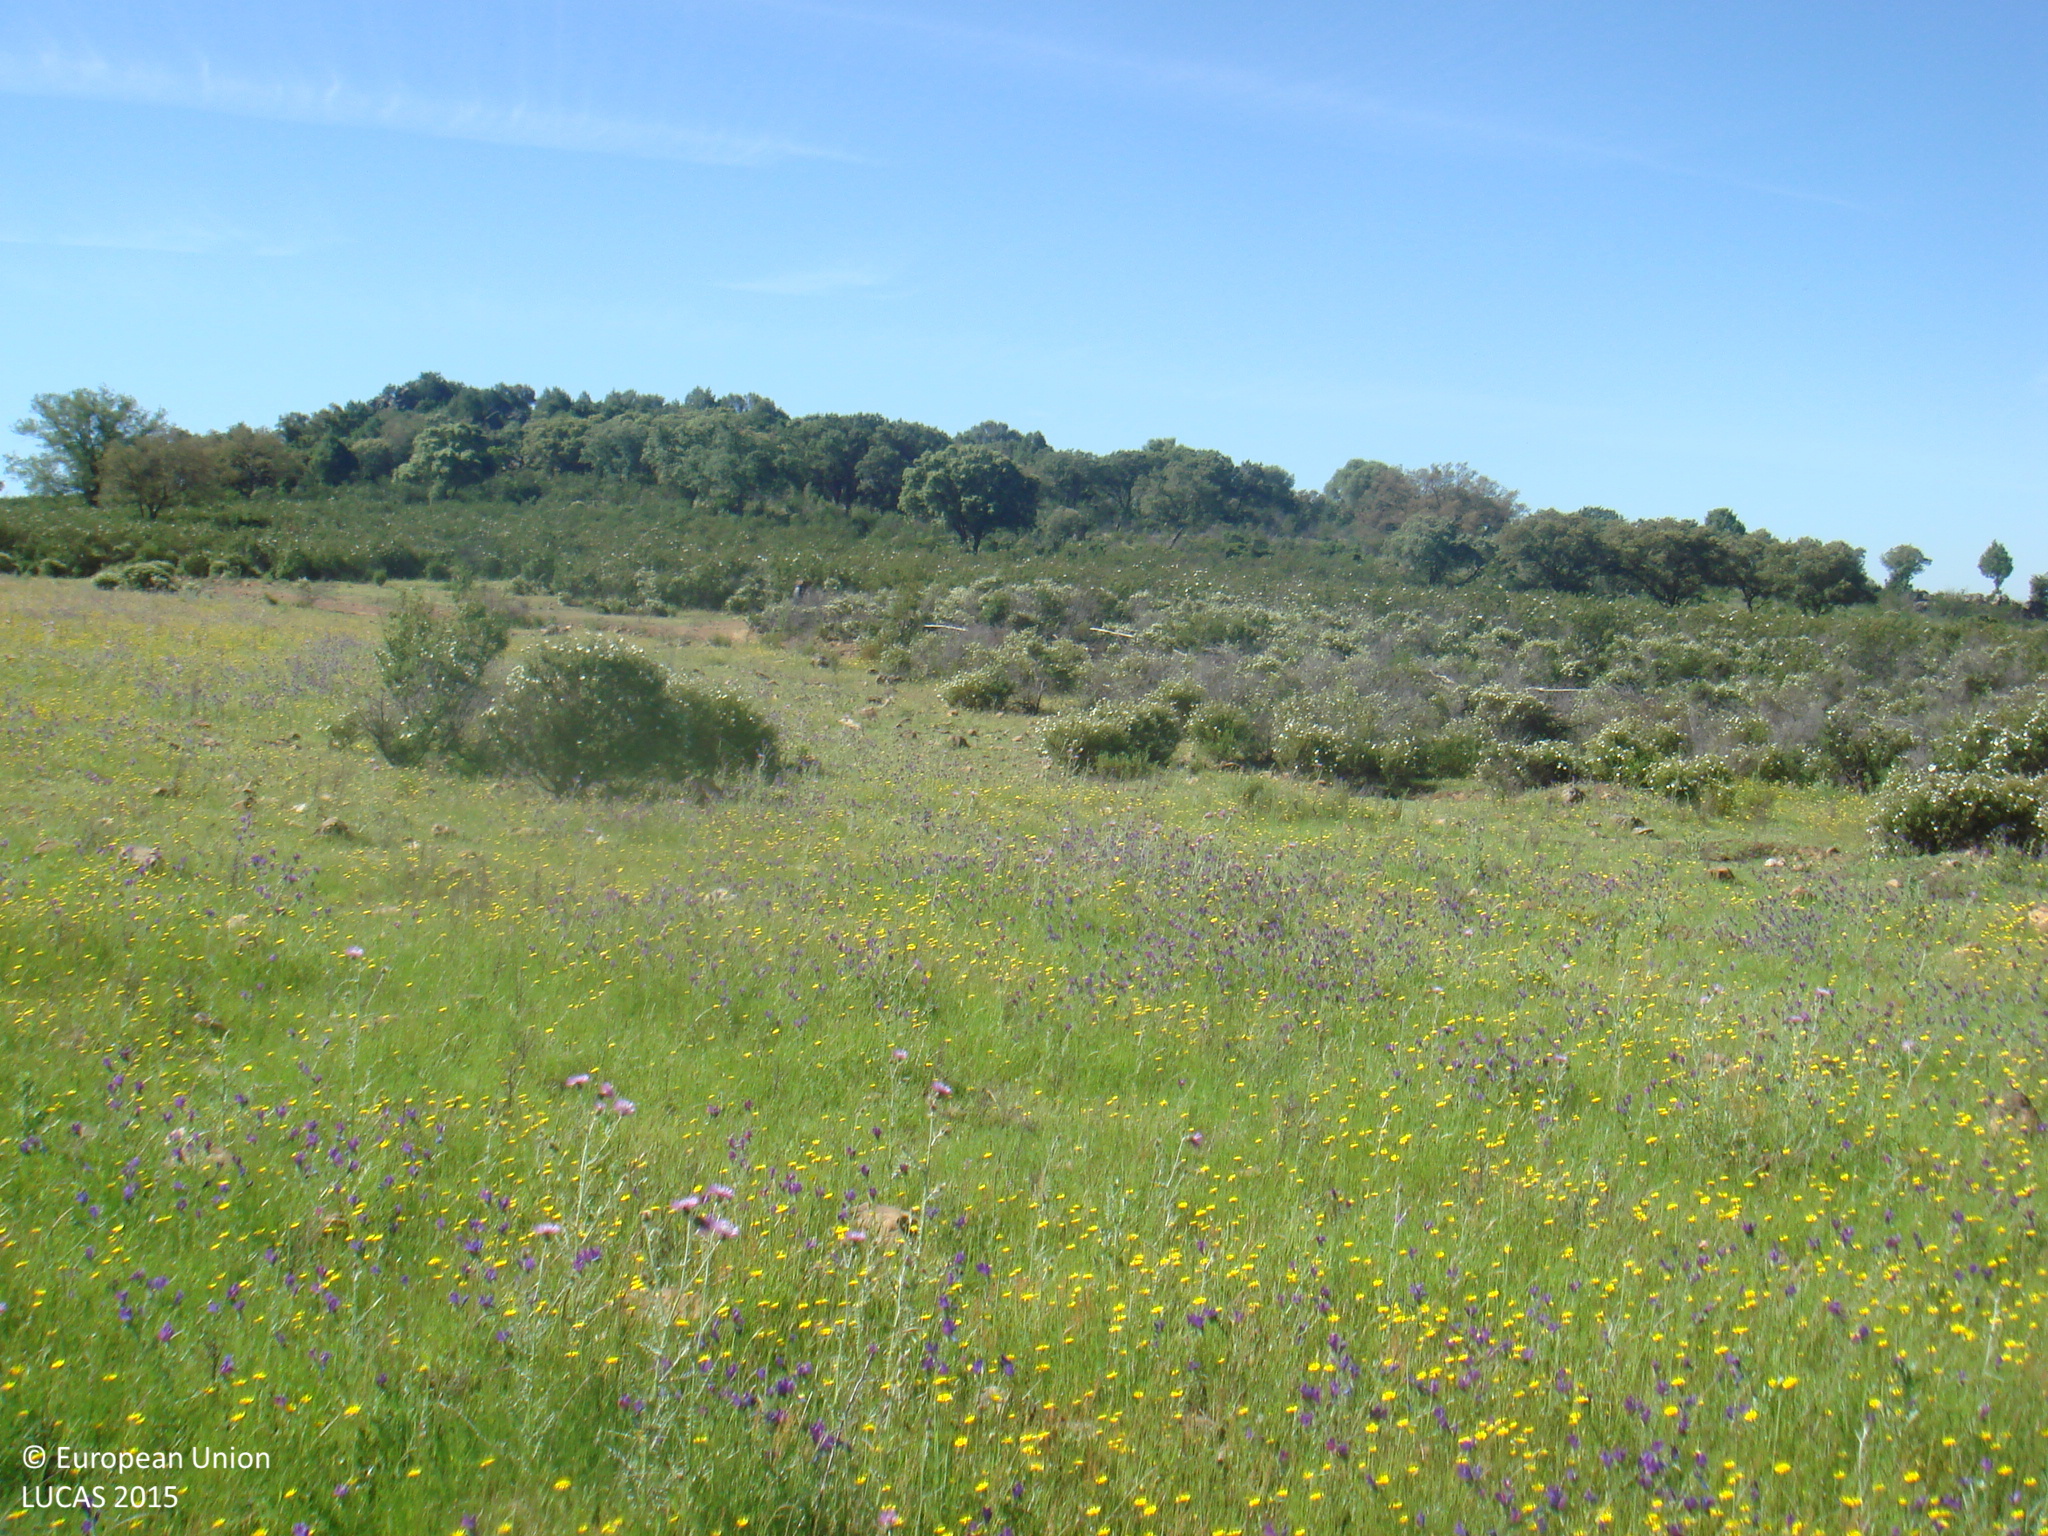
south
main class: Grassland
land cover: Spontaneously vegetated surfaces
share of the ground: > 75 %
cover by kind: herbaceous plants 95 %, shrubs 5 %
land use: Agriculture (excluding fallow land and kitchen gardens)
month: May
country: ES
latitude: 38.4431
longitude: -4.4205
